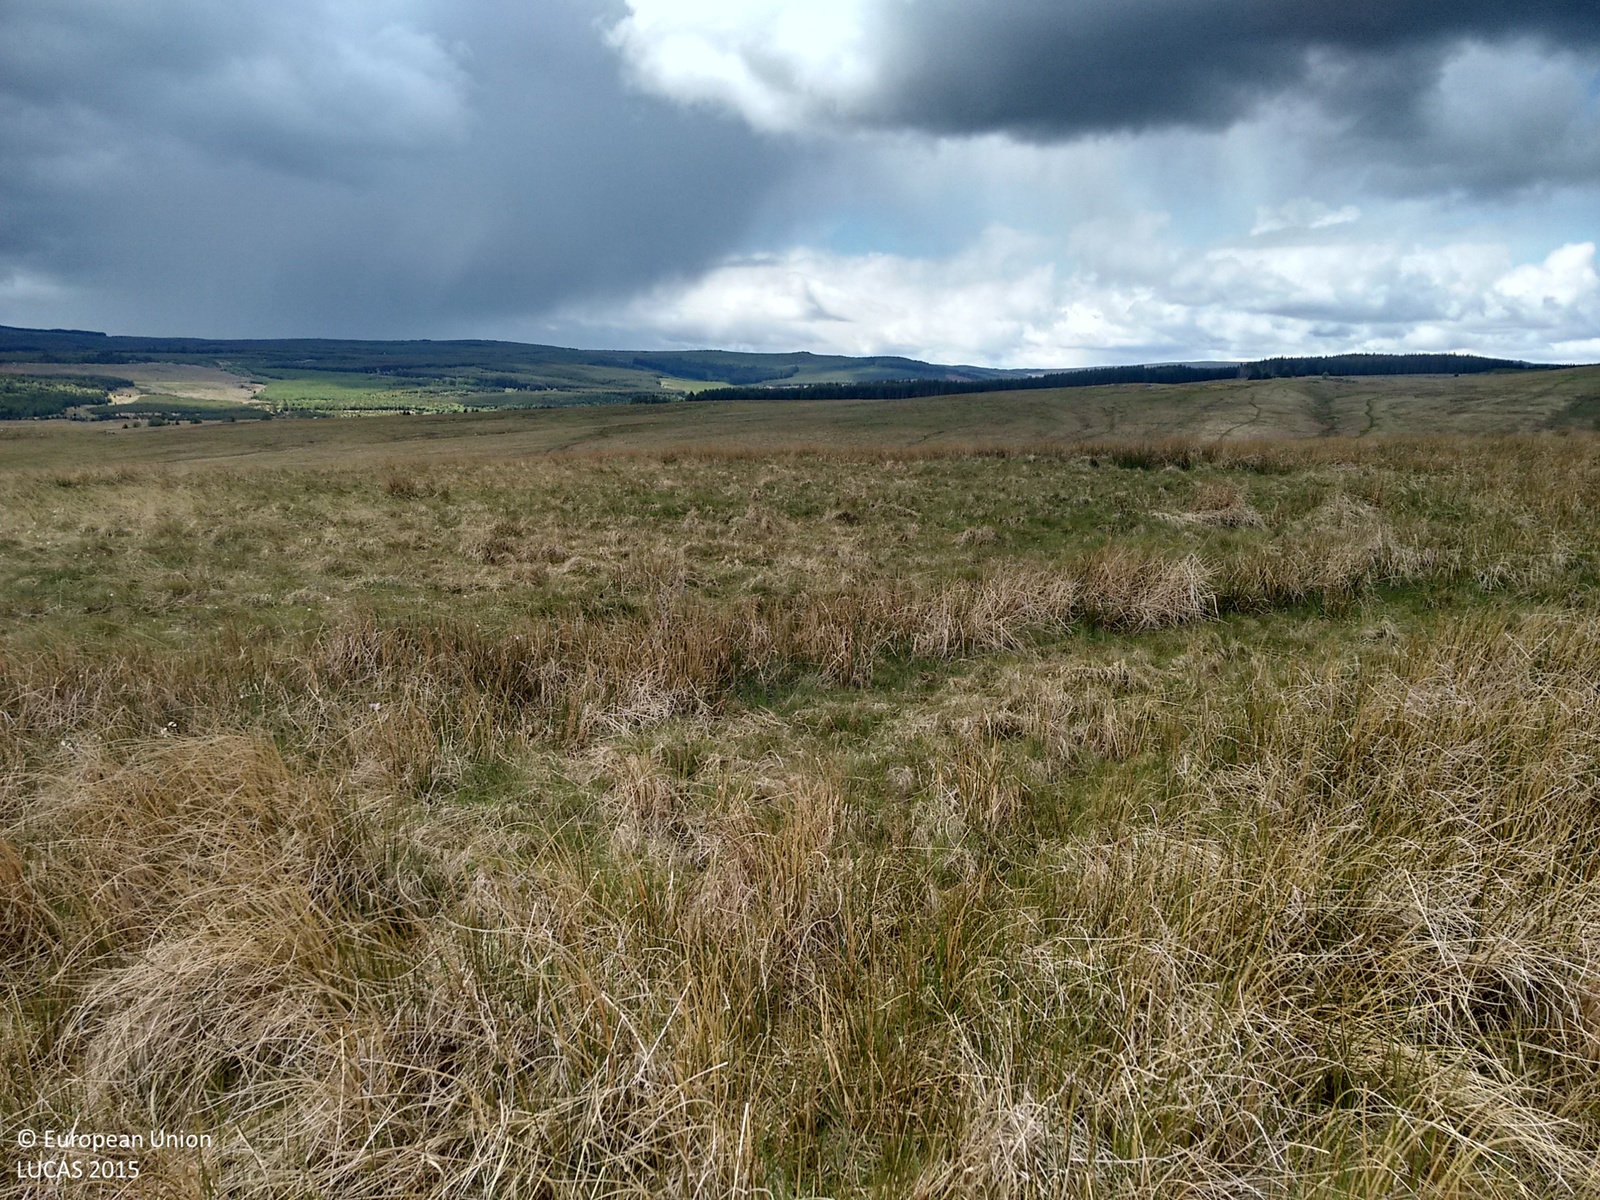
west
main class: Grassland
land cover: Grassland without tree/shrub cover
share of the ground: > 75 %
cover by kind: herbaceous plants 100 %
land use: Agriculture (excluding fallow land and kitchen gardens)
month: May
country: GB
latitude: 55.3021
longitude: -2.2974
